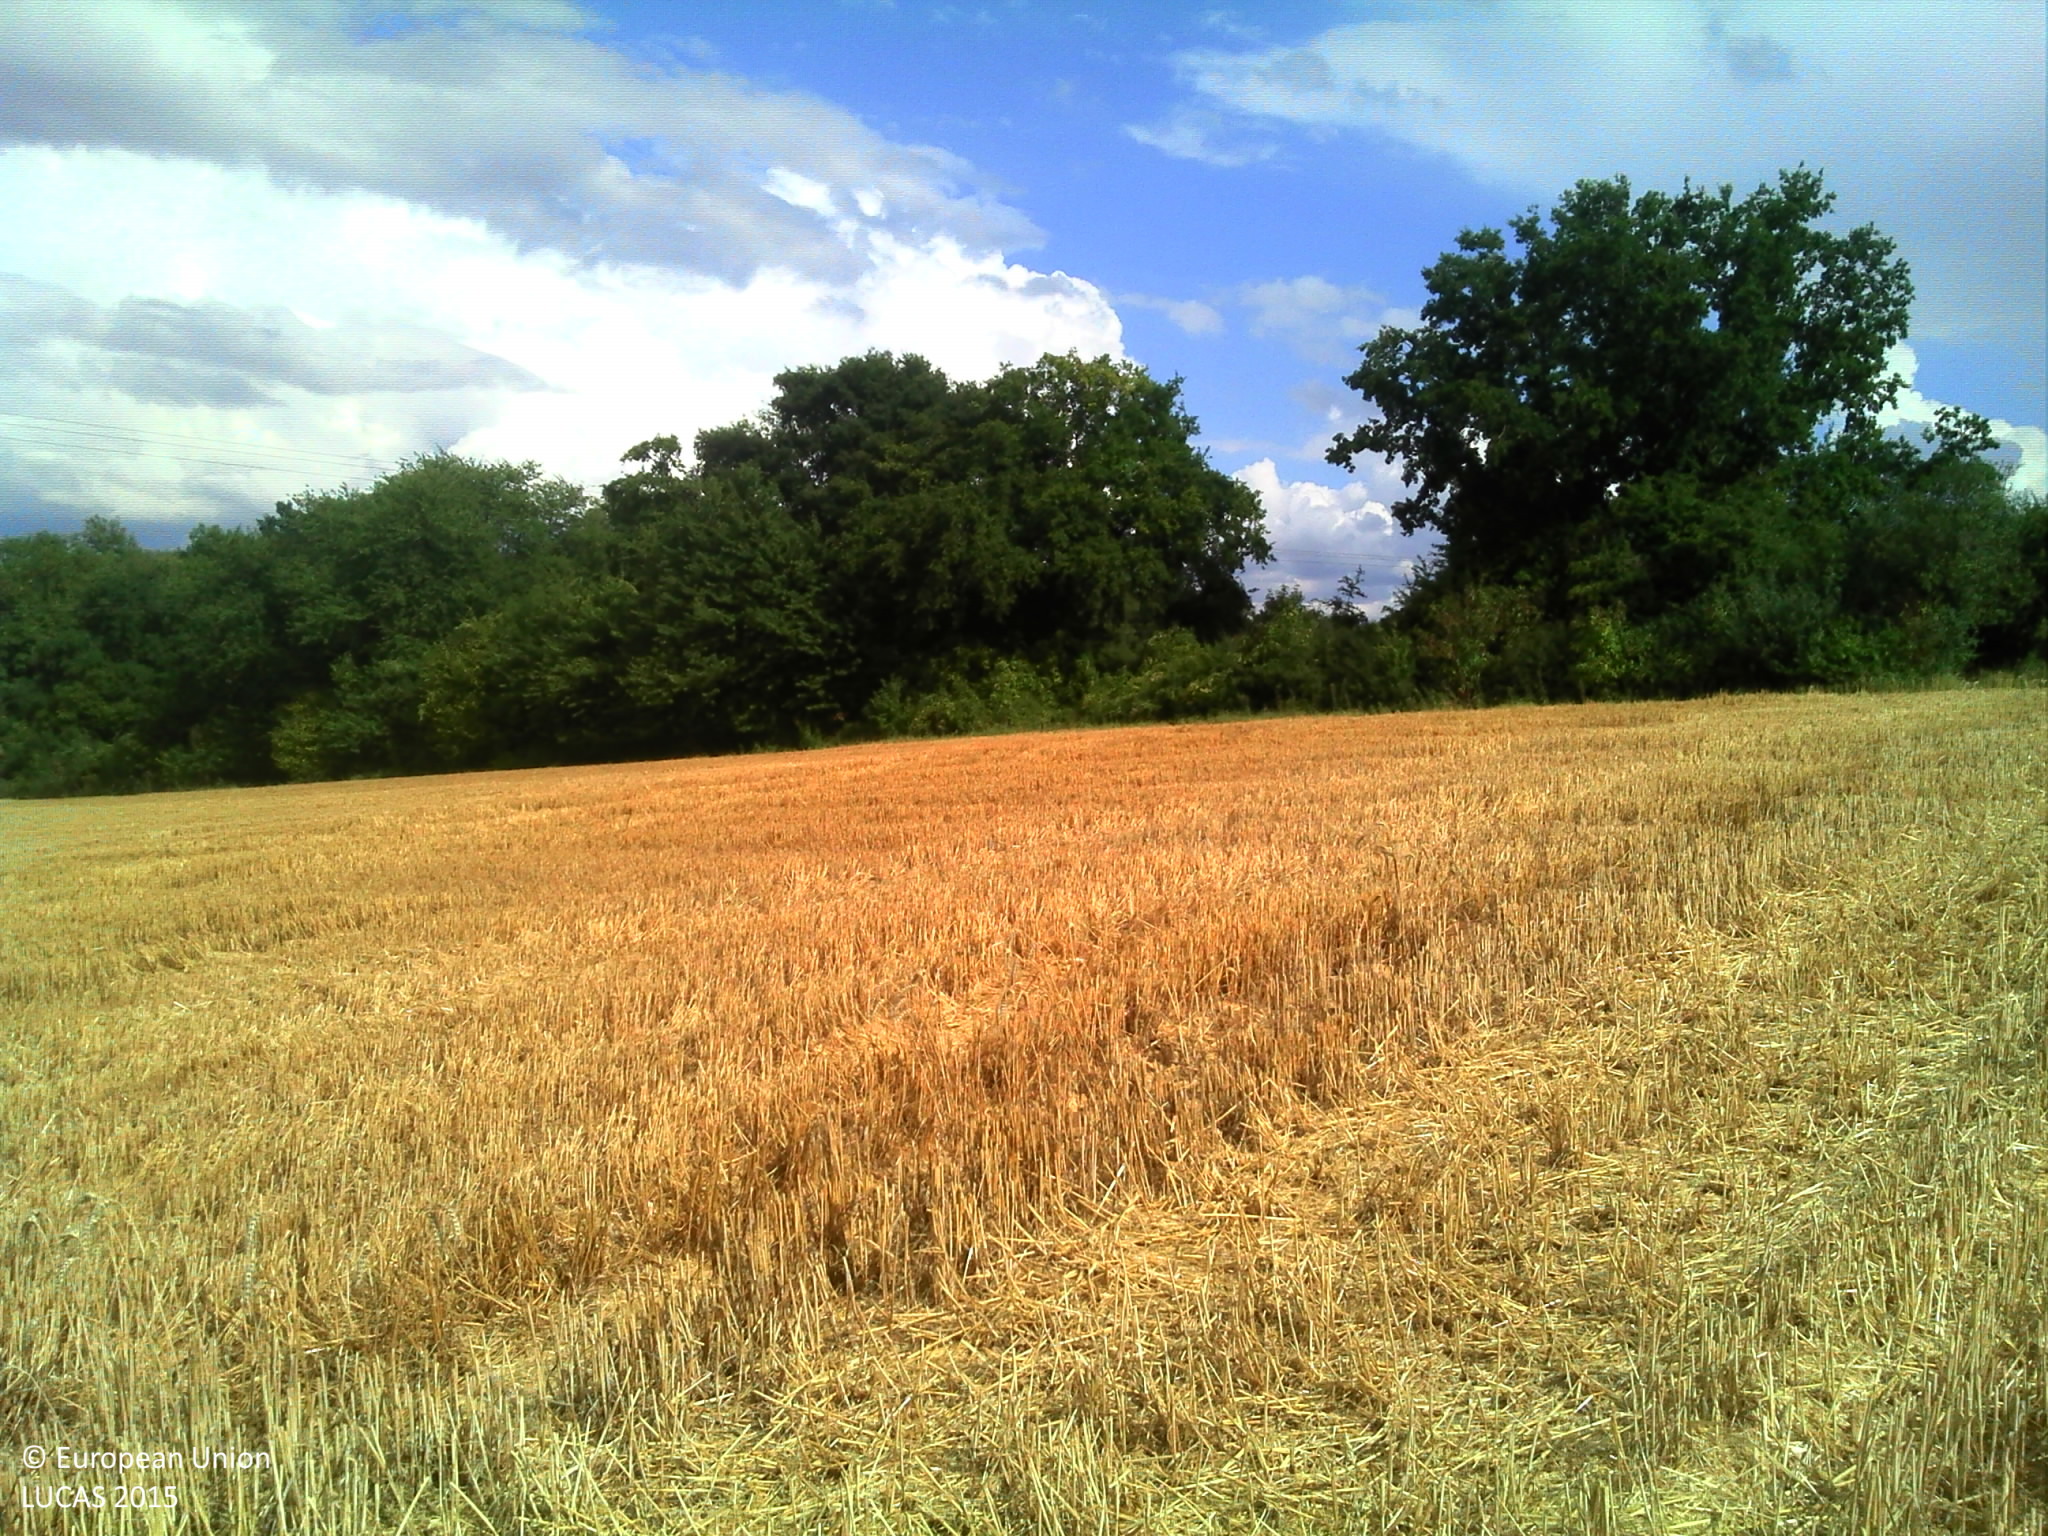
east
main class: Cropland
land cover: Common wheat
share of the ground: > 75 %
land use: Agriculture (excluding fallow land and kitchen gardens)
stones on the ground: < 10 %
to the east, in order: Common wheat; Lines of trees; Electric lines; Sugar beet; Broadleaved woodland
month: August
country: FR
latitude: 49.0877
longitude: 1.9749
